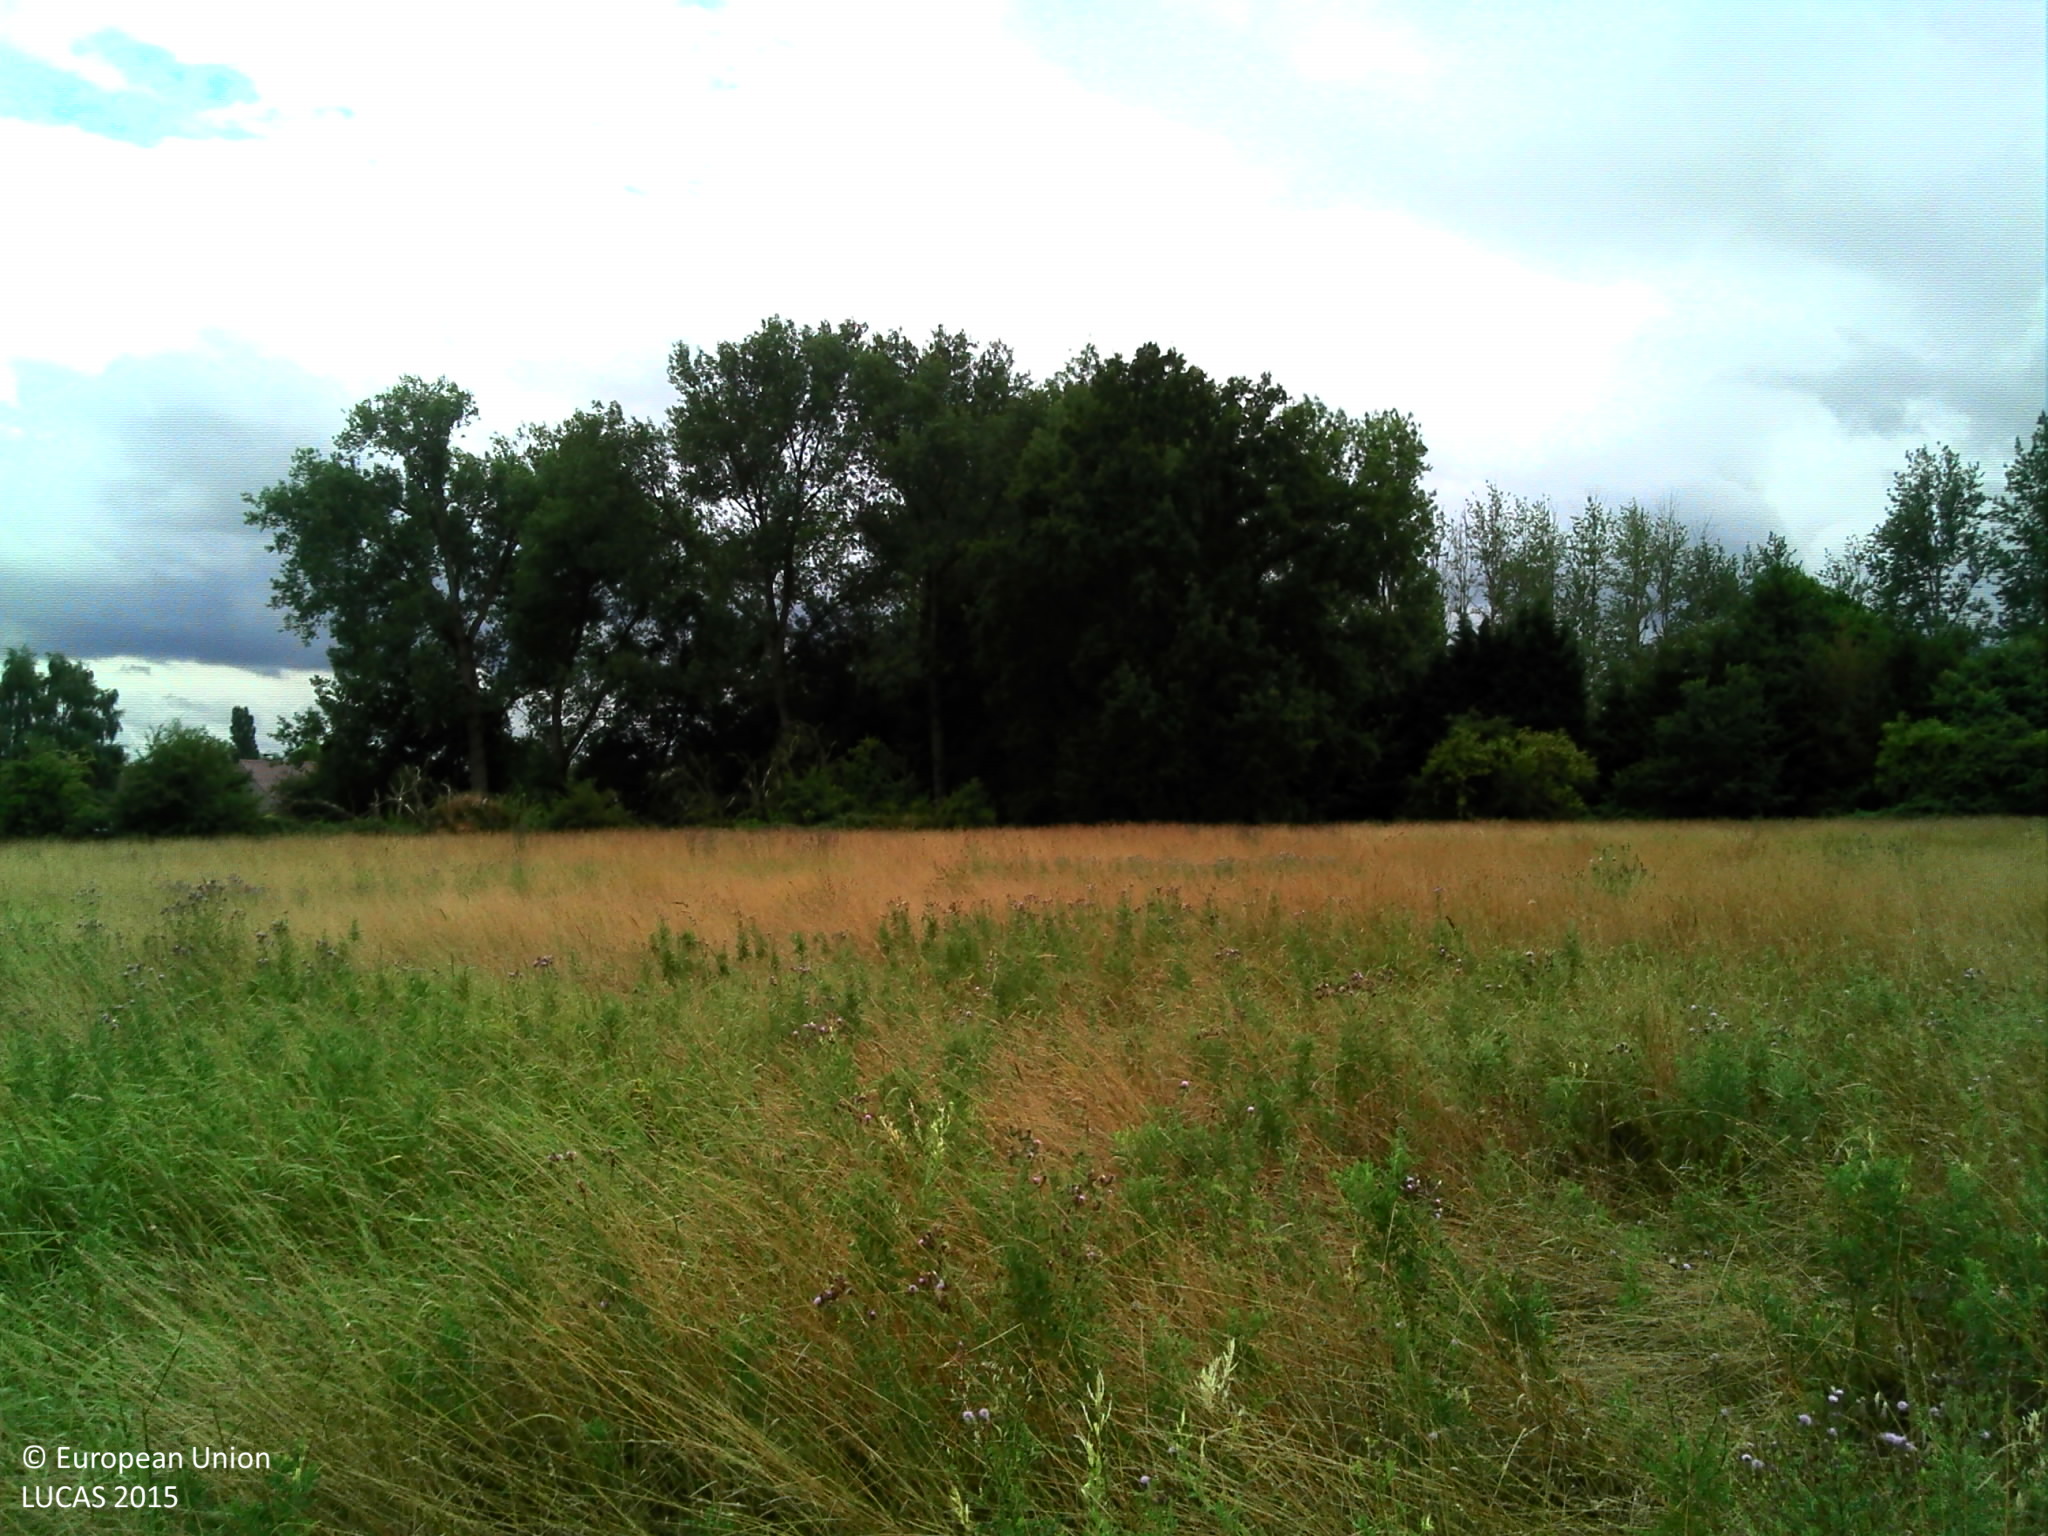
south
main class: Grassland
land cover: Grassland without tree/shrub cover
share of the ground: > 75 %
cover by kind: herbaceous plants 95 %, shrubs 5 %
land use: Agriculture (excluding fallow land and kitchen gardens)
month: July
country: BE
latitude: 50.8713
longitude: 5.0947
